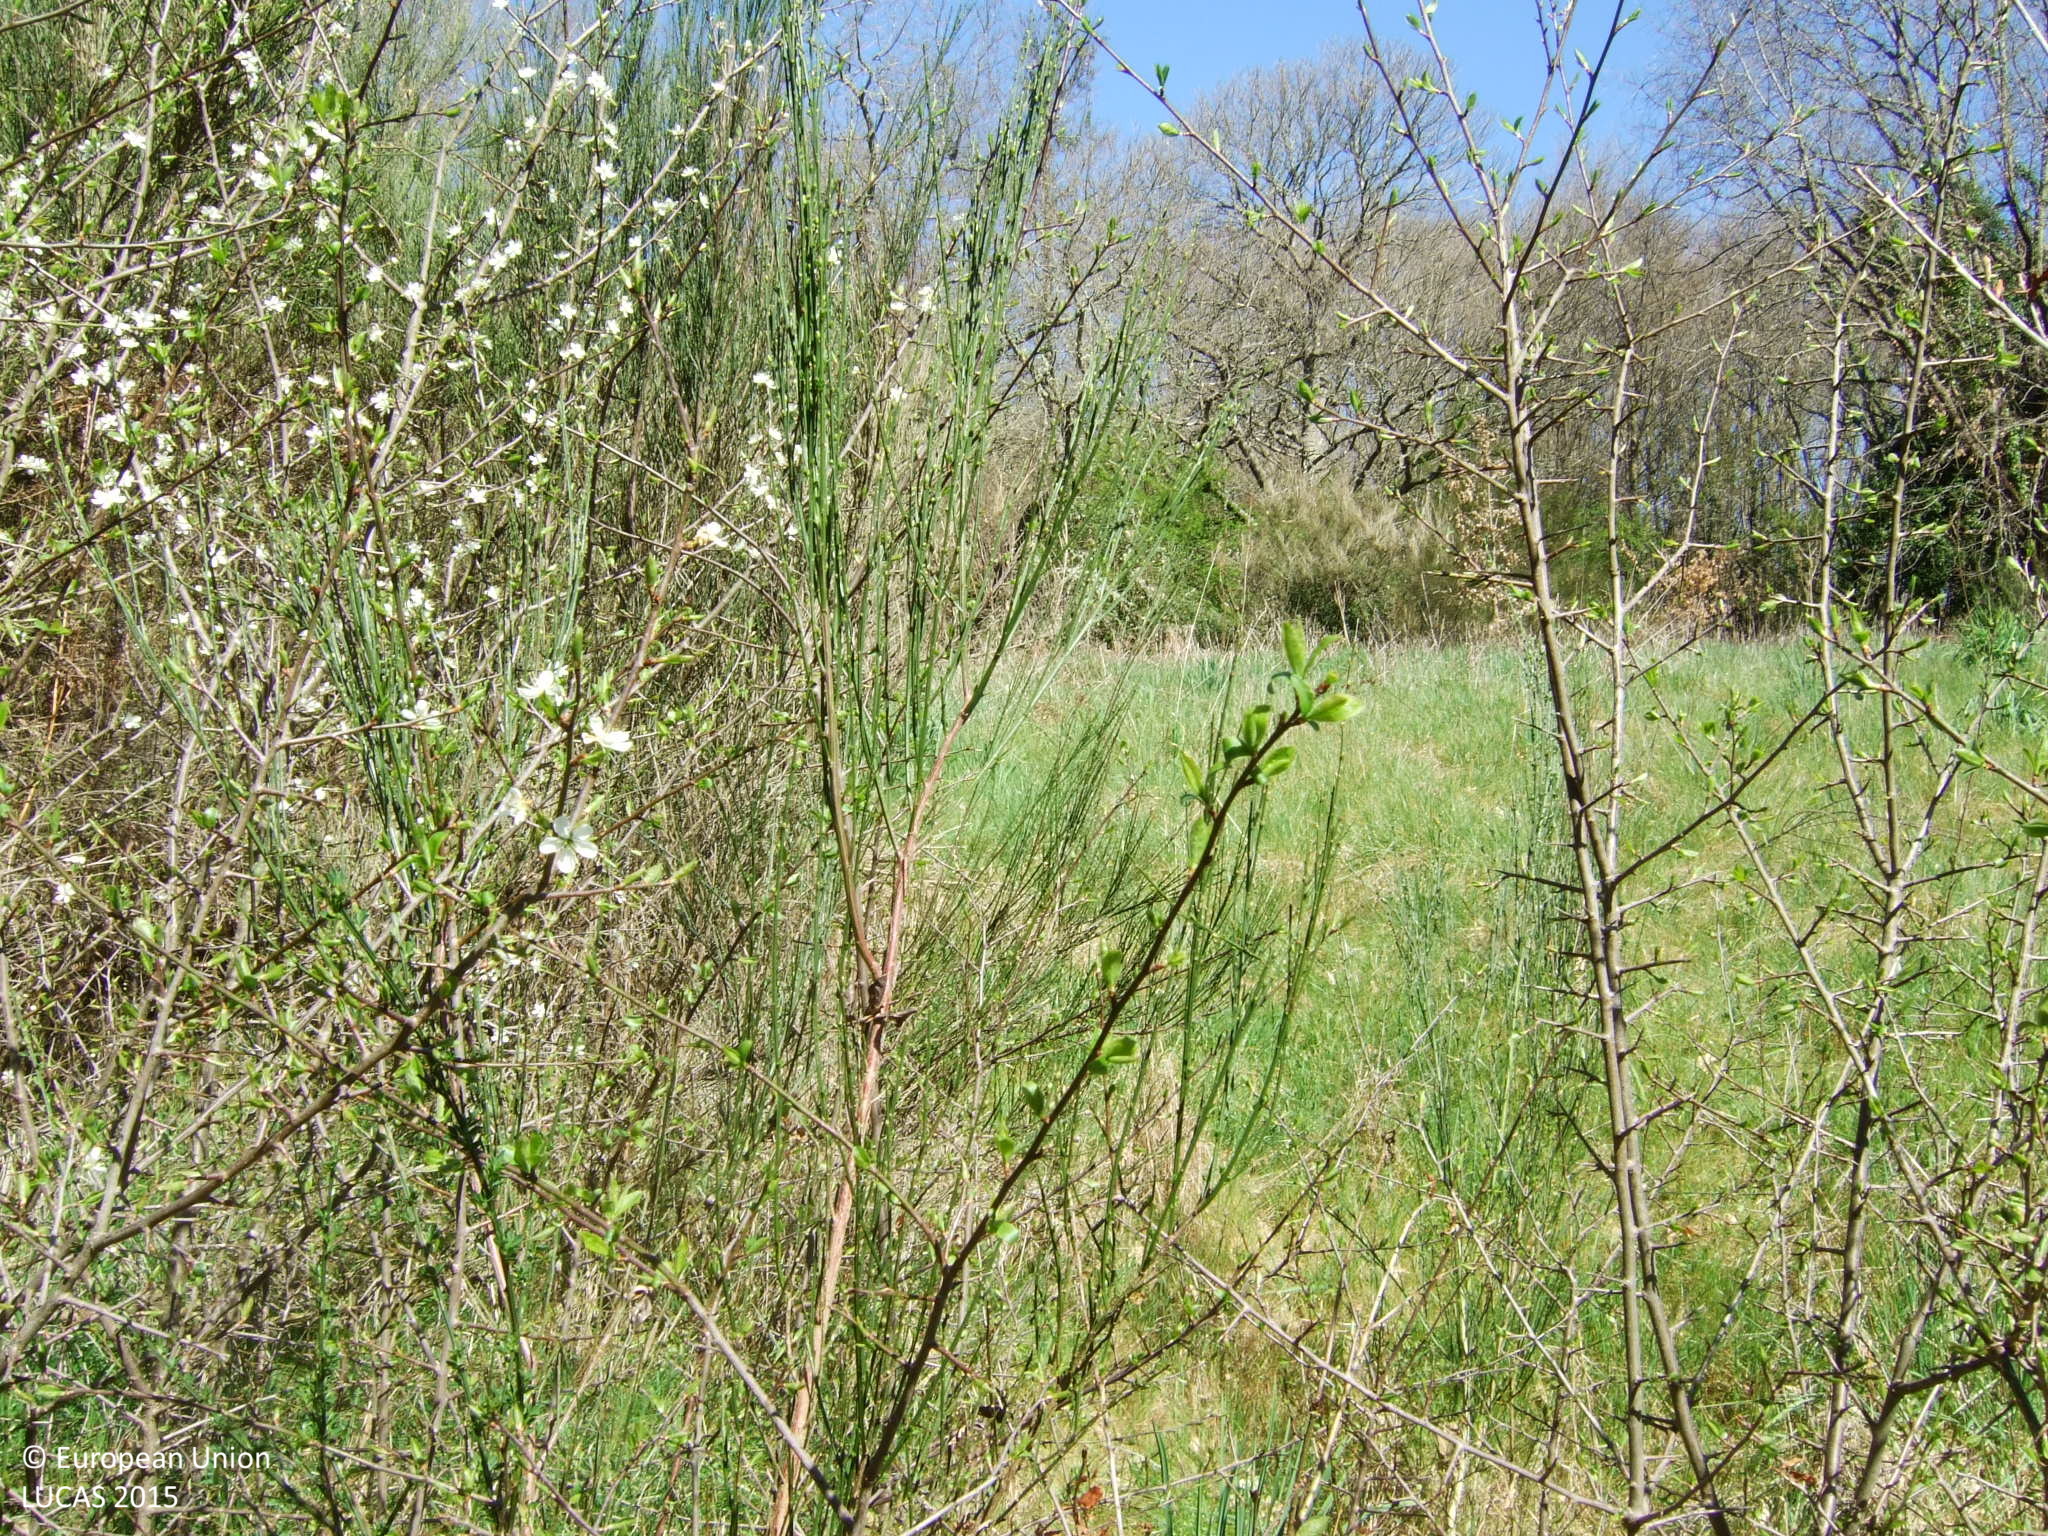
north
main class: Shrubland
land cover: Shrubland with sparse tree cover
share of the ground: > 75 %
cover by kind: shrubs 75 %, herbaceous plants 20 %, broadleaved forest trees 5 %
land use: Semi-natural and natural areas not in use
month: April
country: ES
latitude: 42.7050
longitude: -7.7946
